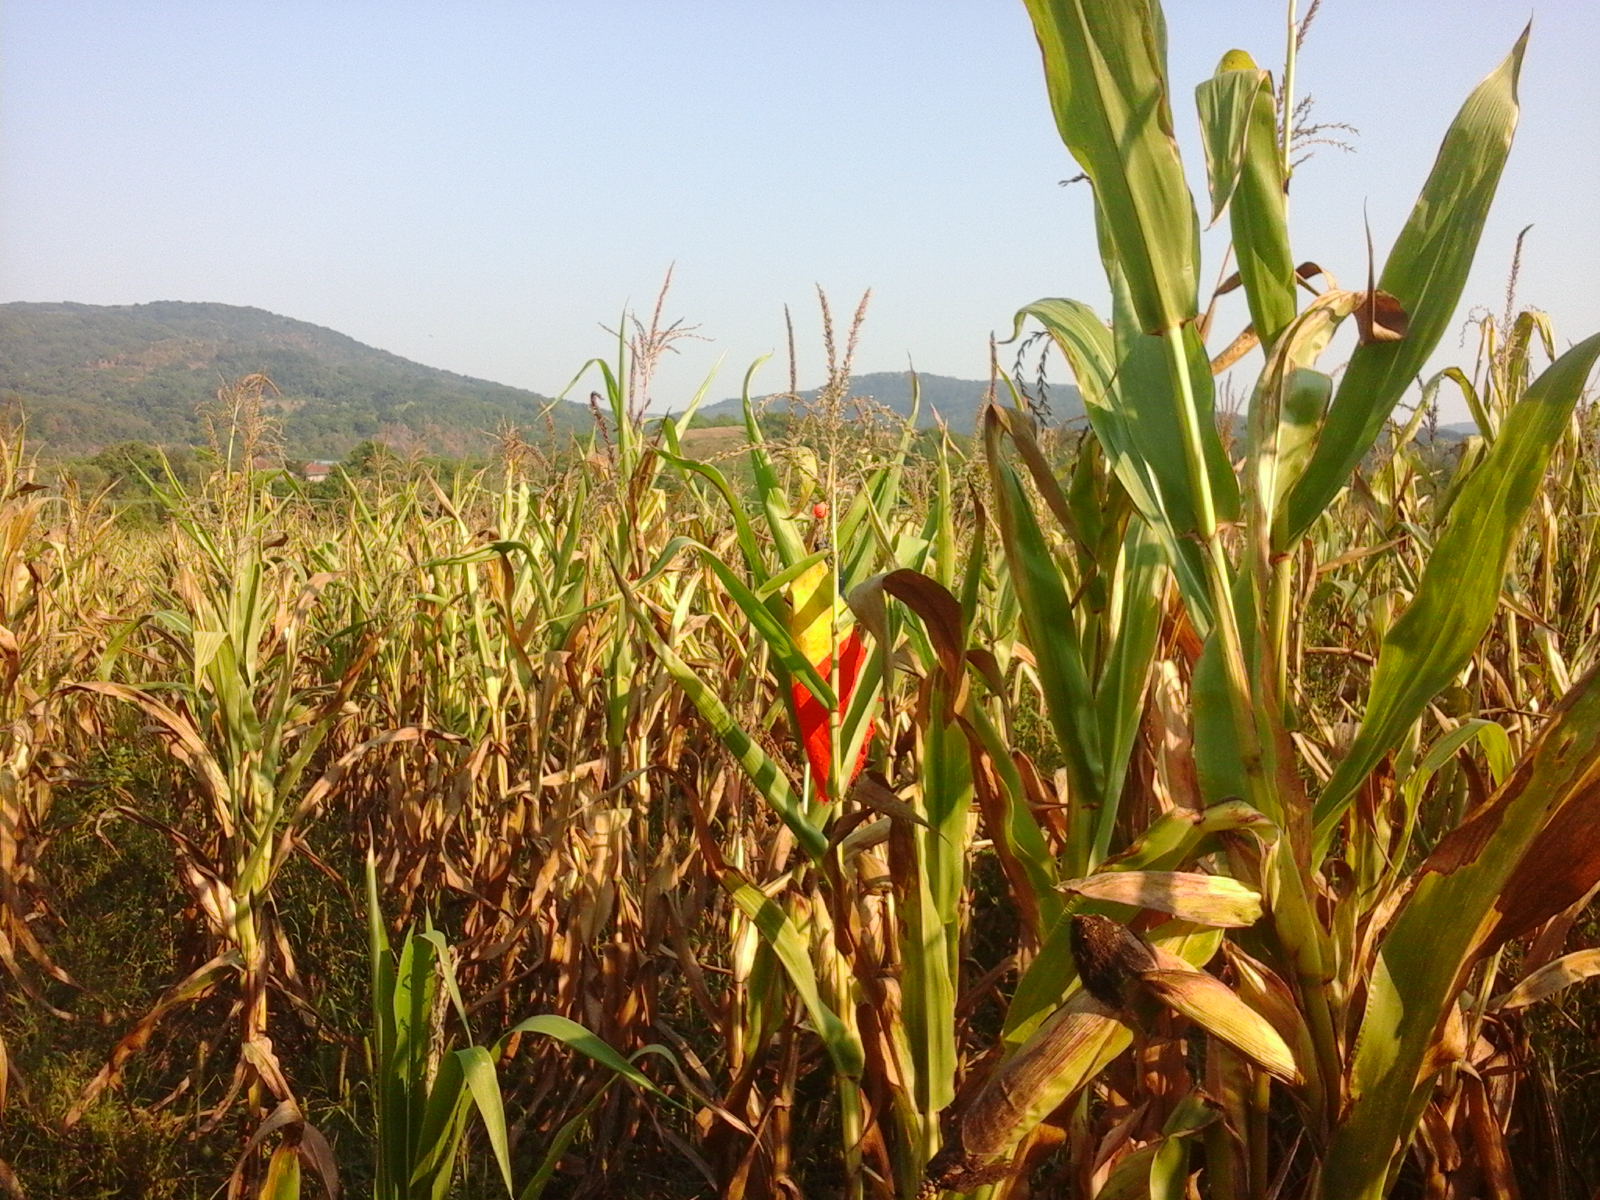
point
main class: Cropland
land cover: Maize
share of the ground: > 75 %
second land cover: Spontaneously vegetated surfaces
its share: 10 - 25 %
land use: Agriculture (excluding fallow land and kitchen gardens)
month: August
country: RO
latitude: 46.2537
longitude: 22.3319
